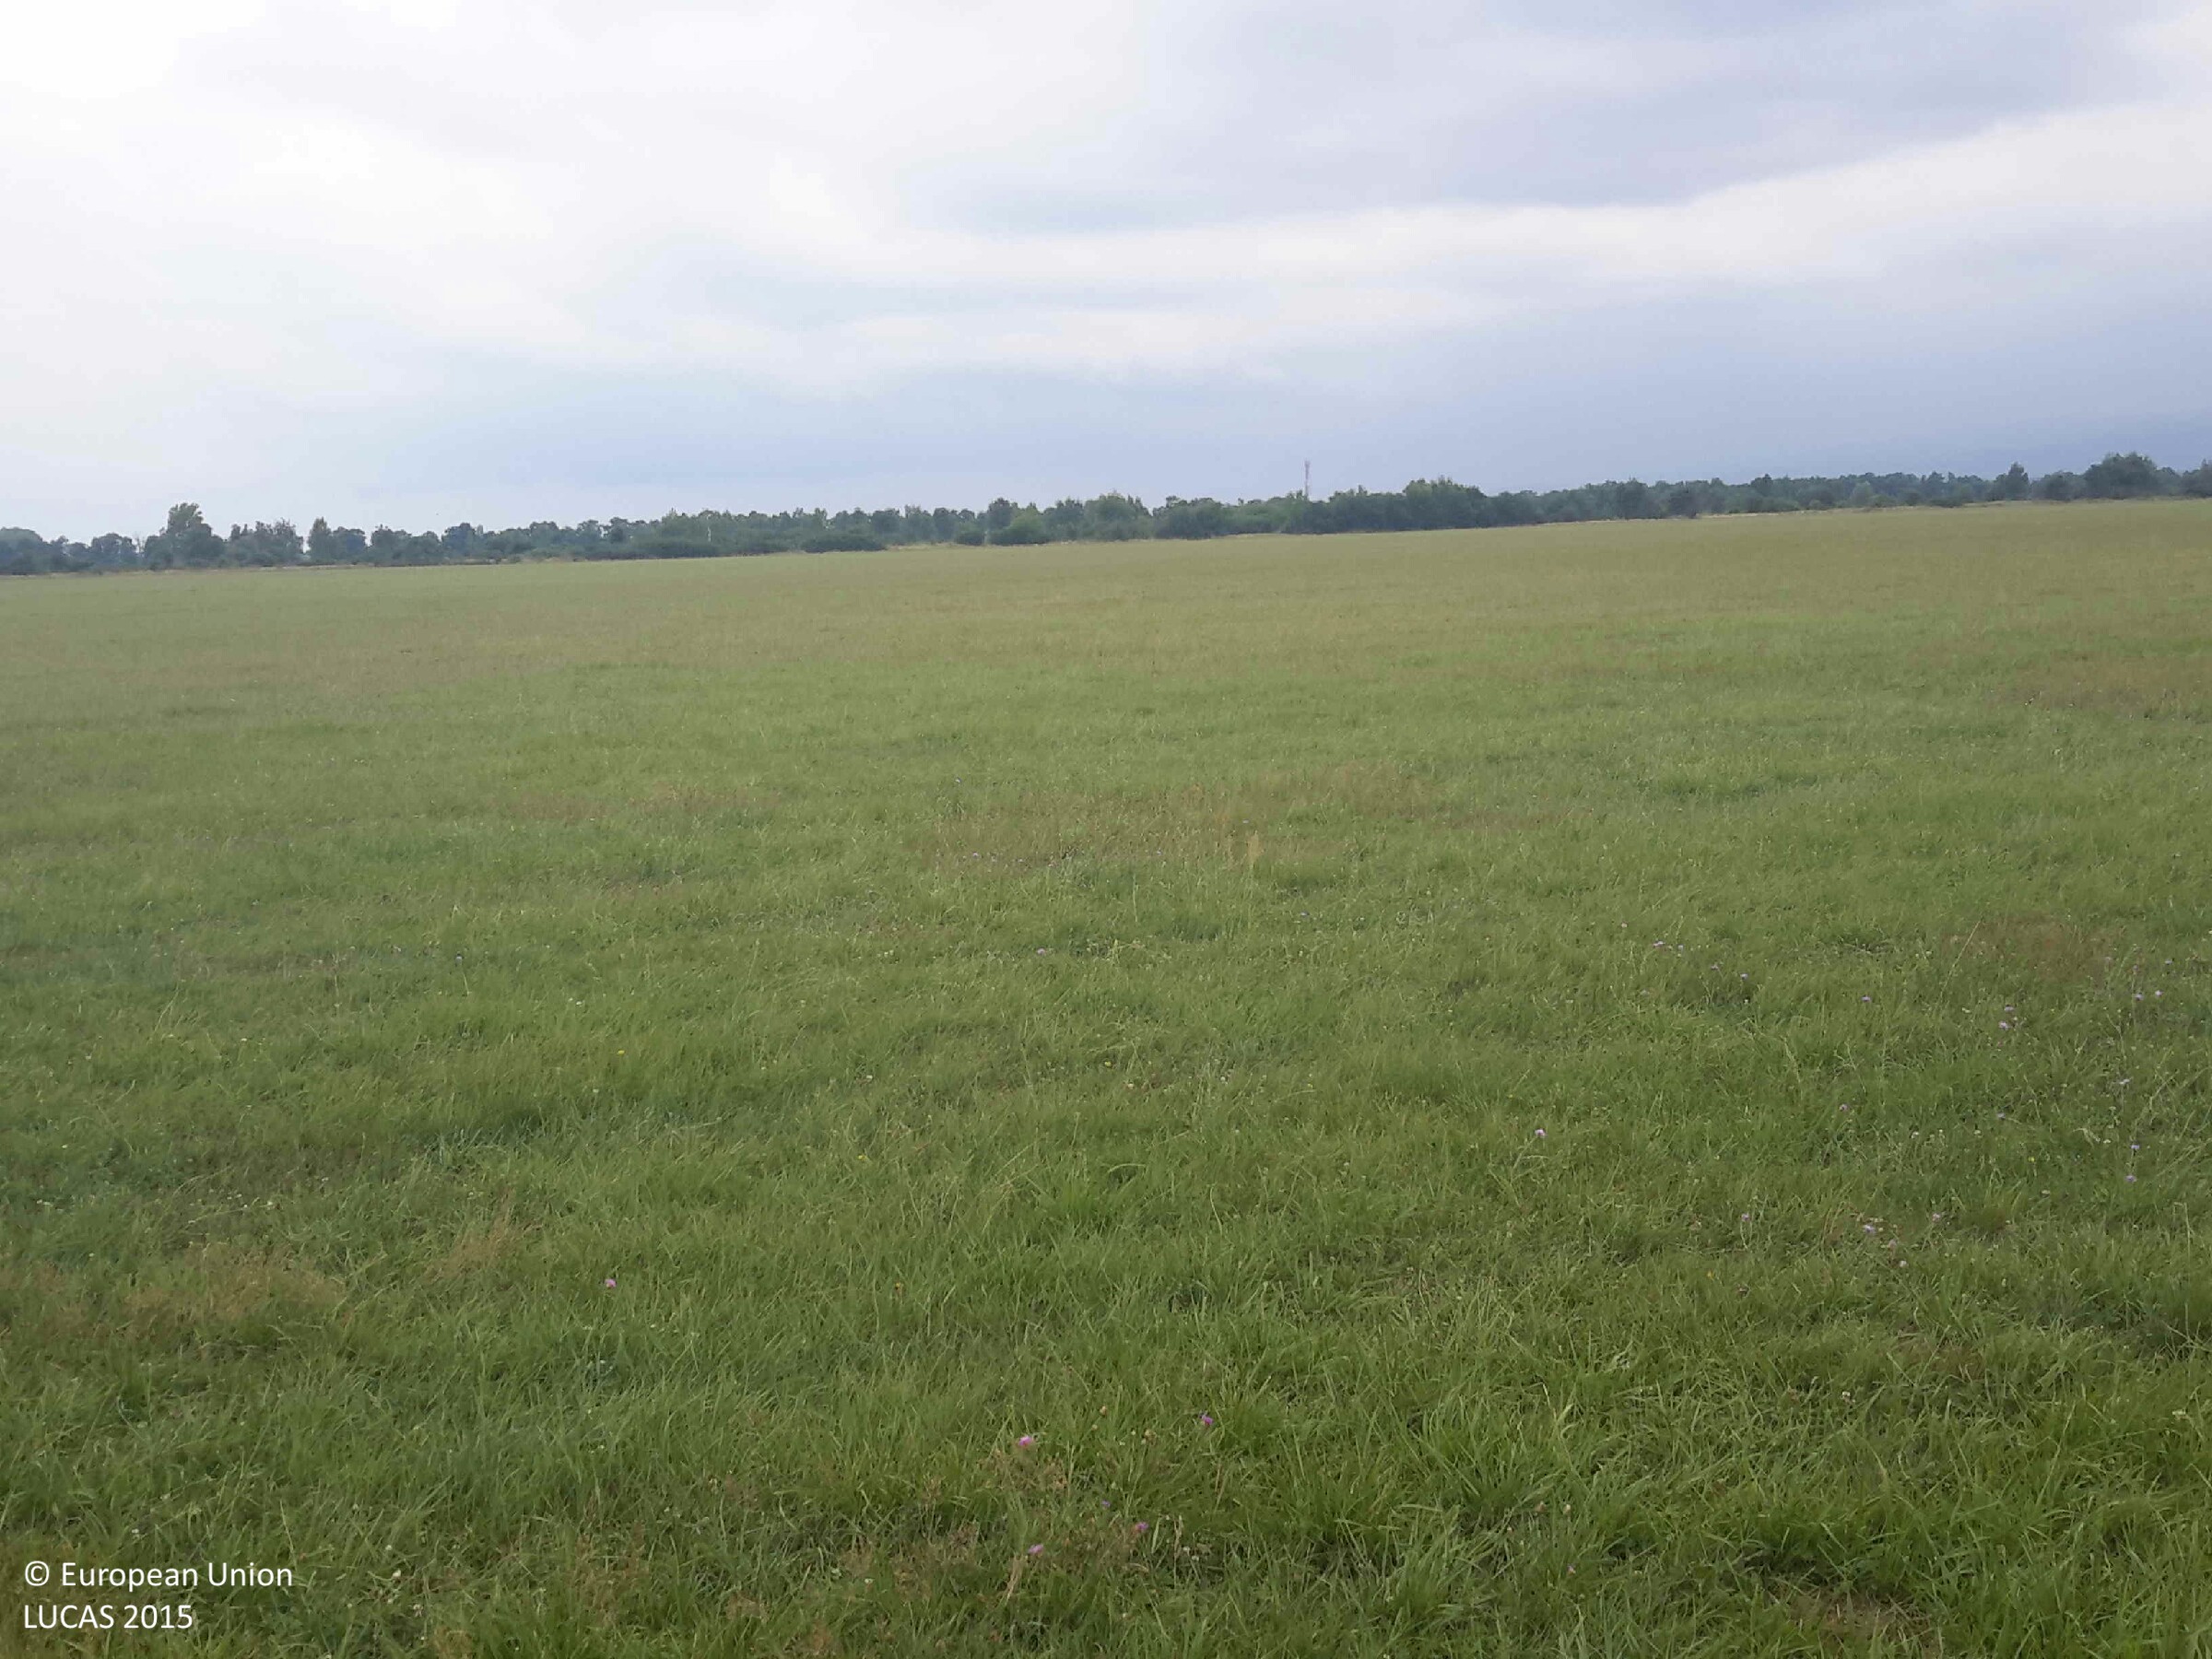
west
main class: Grassland
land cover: Grassland without tree/shrub cover
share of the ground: > 75 %
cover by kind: herbaceous plants 100 %
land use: Agriculture (excluding fallow land and kitchen gardens)
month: July
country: HU
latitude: 47.2837
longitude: 16.6275
